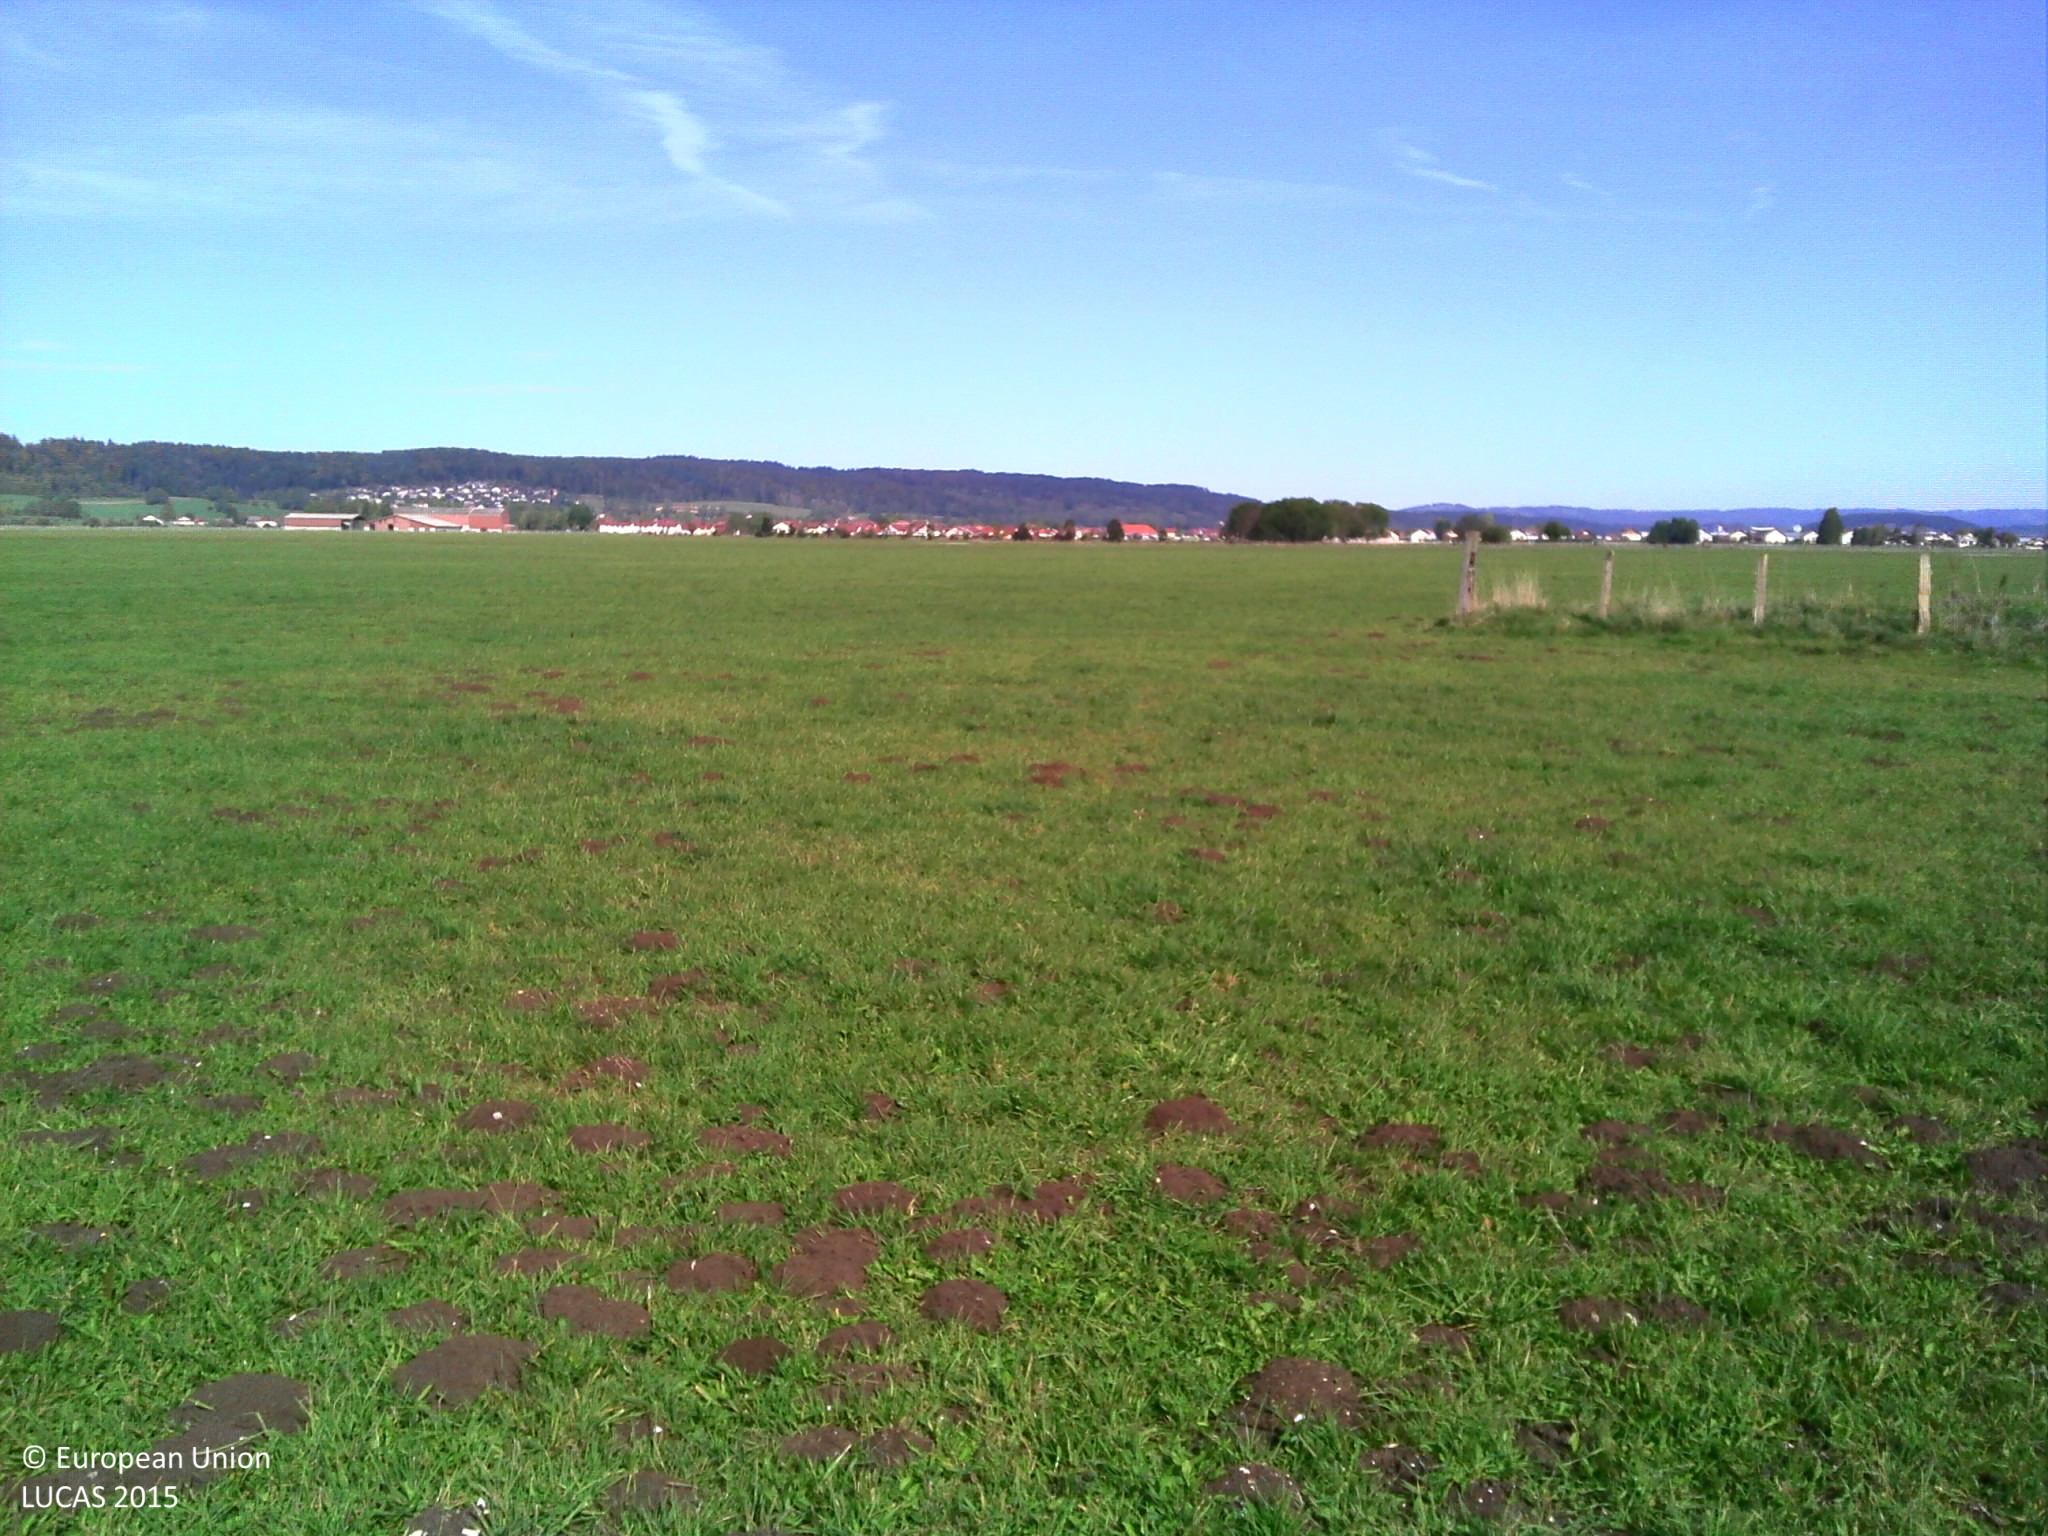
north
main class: Grassland
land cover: Grassland without tree/shrub cover
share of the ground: > 75 %
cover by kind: herbaceous plants 100 %
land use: Agriculture (excluding fallow land and kitchen gardens)
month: October
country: FR
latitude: 46.9006
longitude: 6.3137
